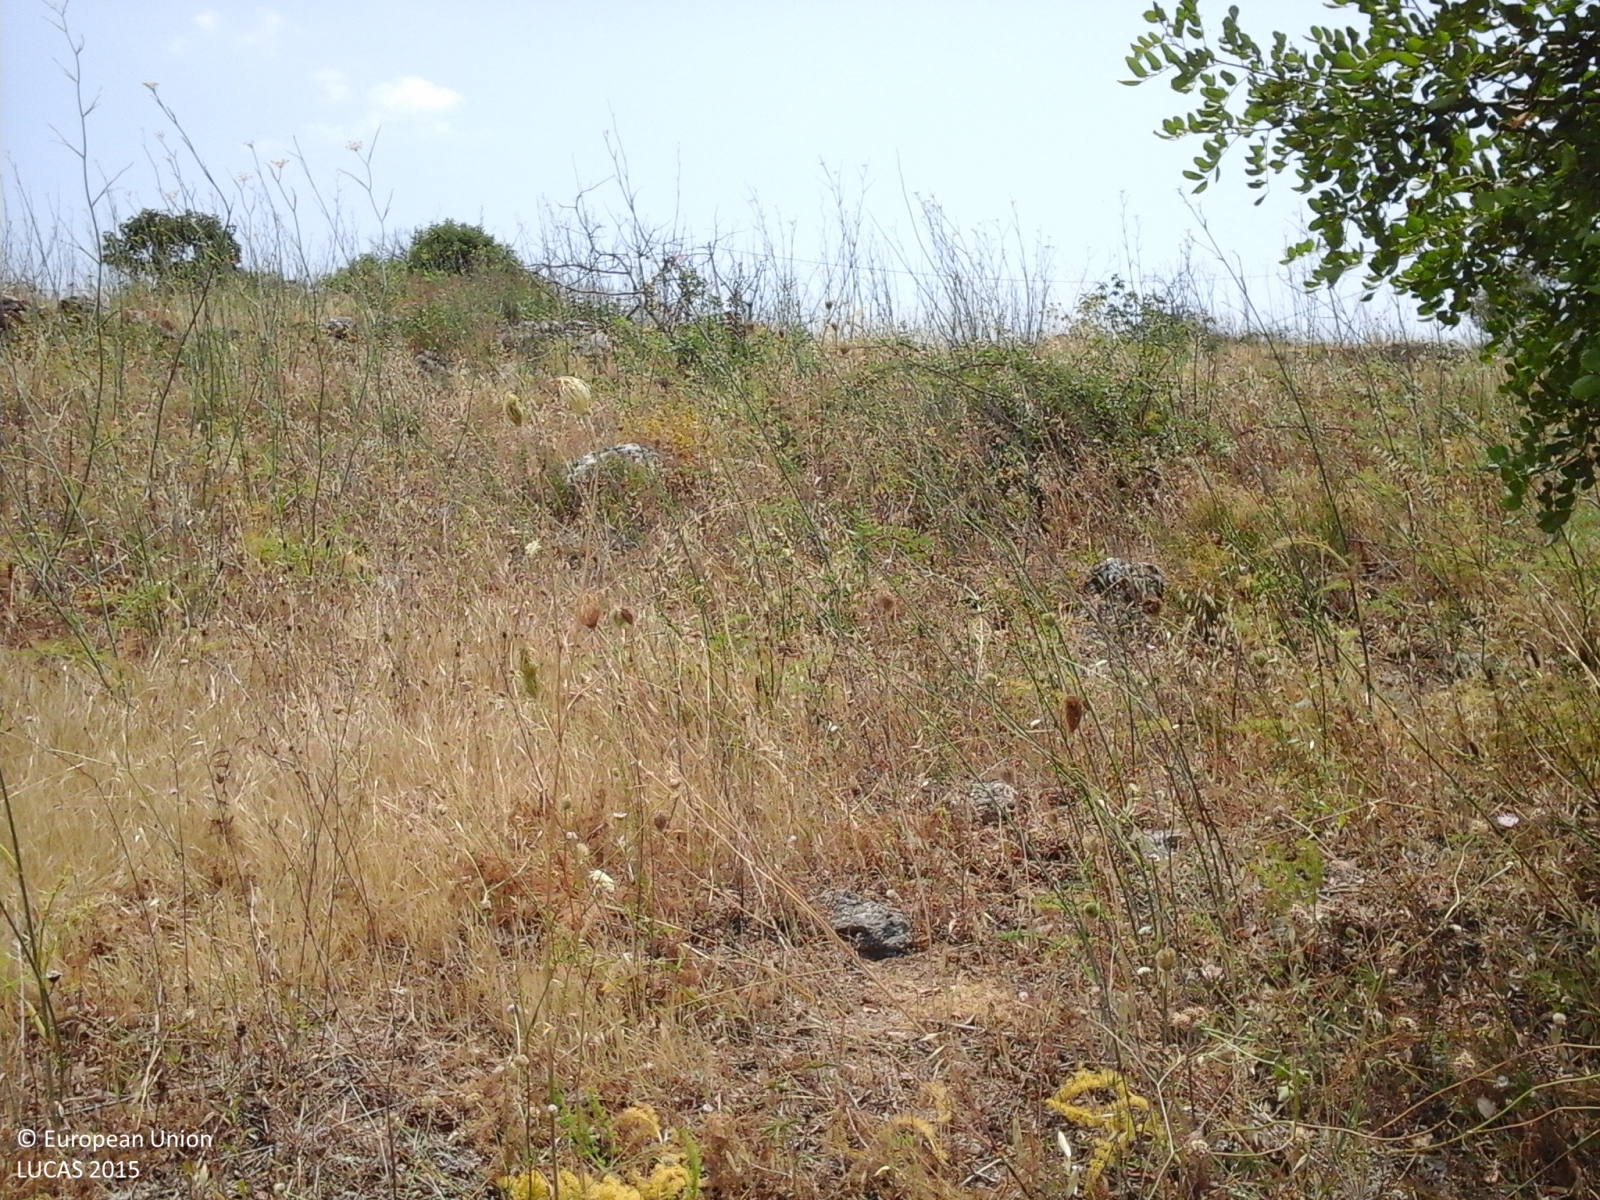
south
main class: Grassland
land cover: Grassland with sparse tree/shrub cover
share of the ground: > 75 %
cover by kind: herbaceous plants 85 %, shrubs 10 %, coniferous forest trees 5 %
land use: Semi-natural and natural areas not in use
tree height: > 5 m
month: July
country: IT
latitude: 37.2837
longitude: 13.9509
